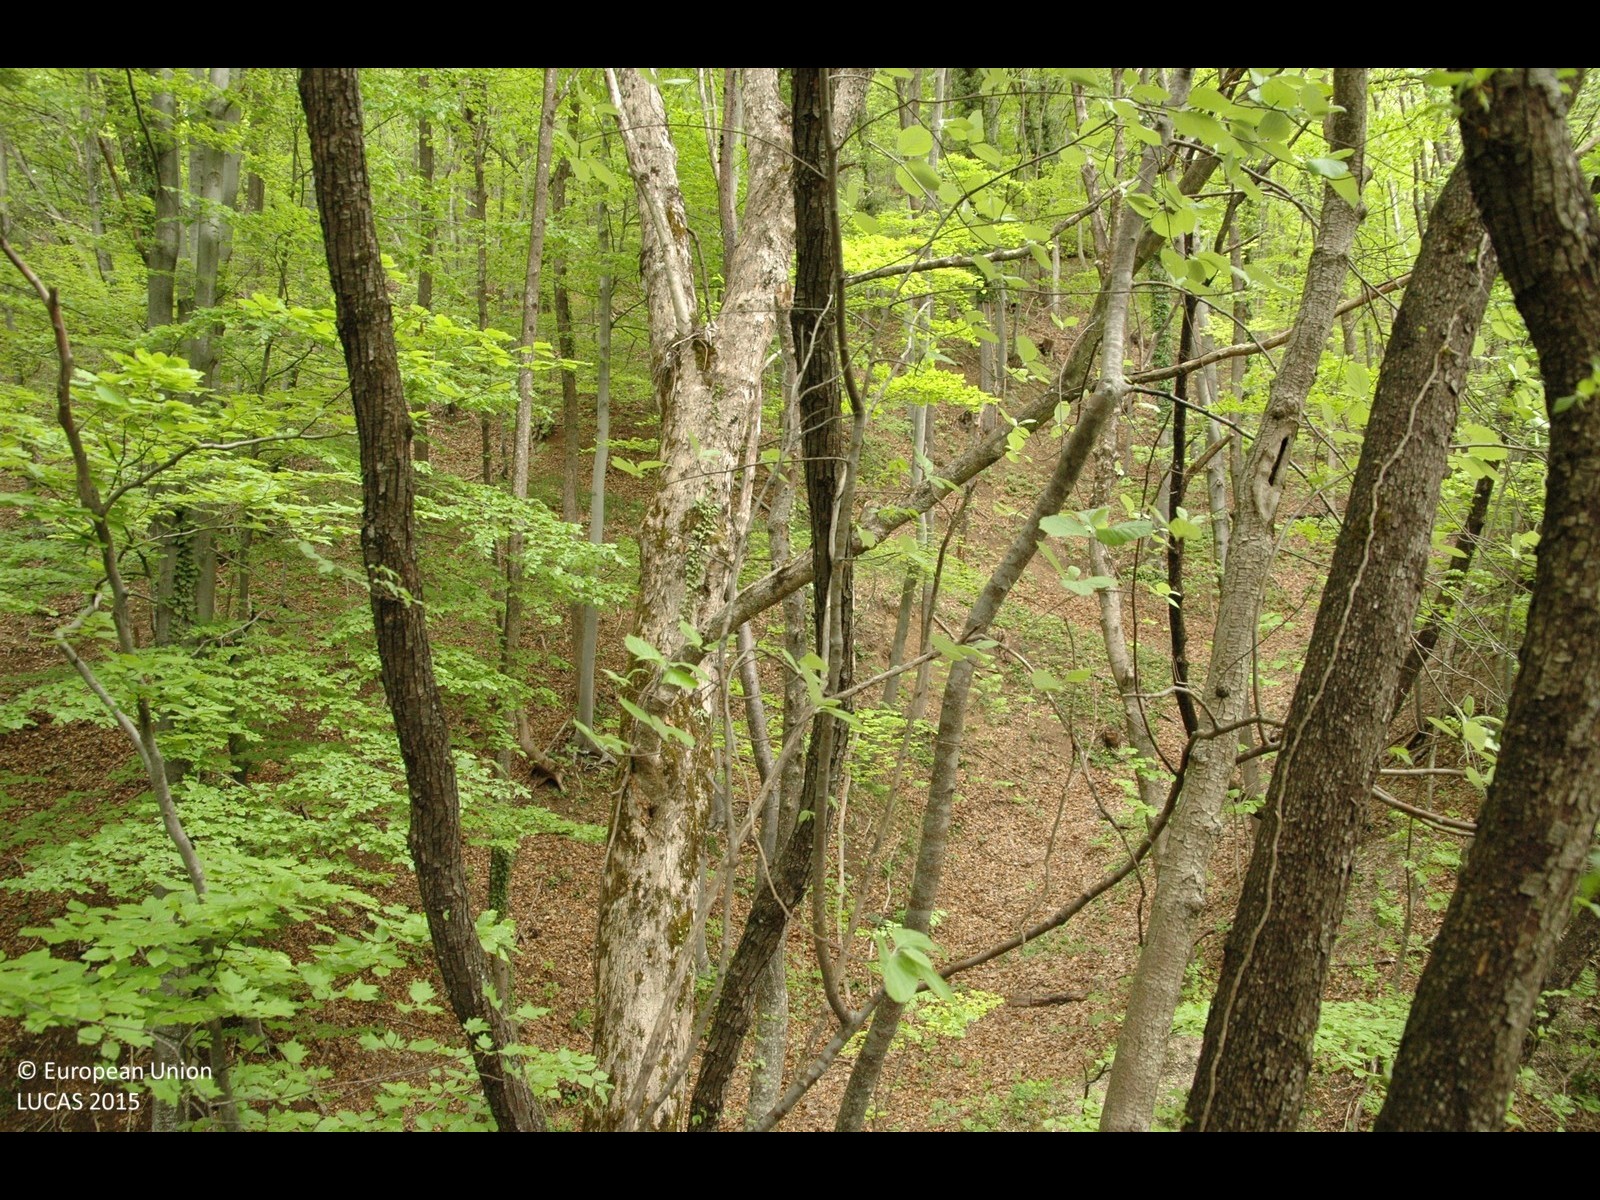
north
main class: Woodland
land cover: Broadleaved woodland
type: beech forest
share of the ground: > 75 %
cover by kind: broadleaved forest trees 95 %, consolidated bare surface 5 %
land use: Forestry
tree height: > 5 m
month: May
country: HR
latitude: 45.8021
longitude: 15.6972
